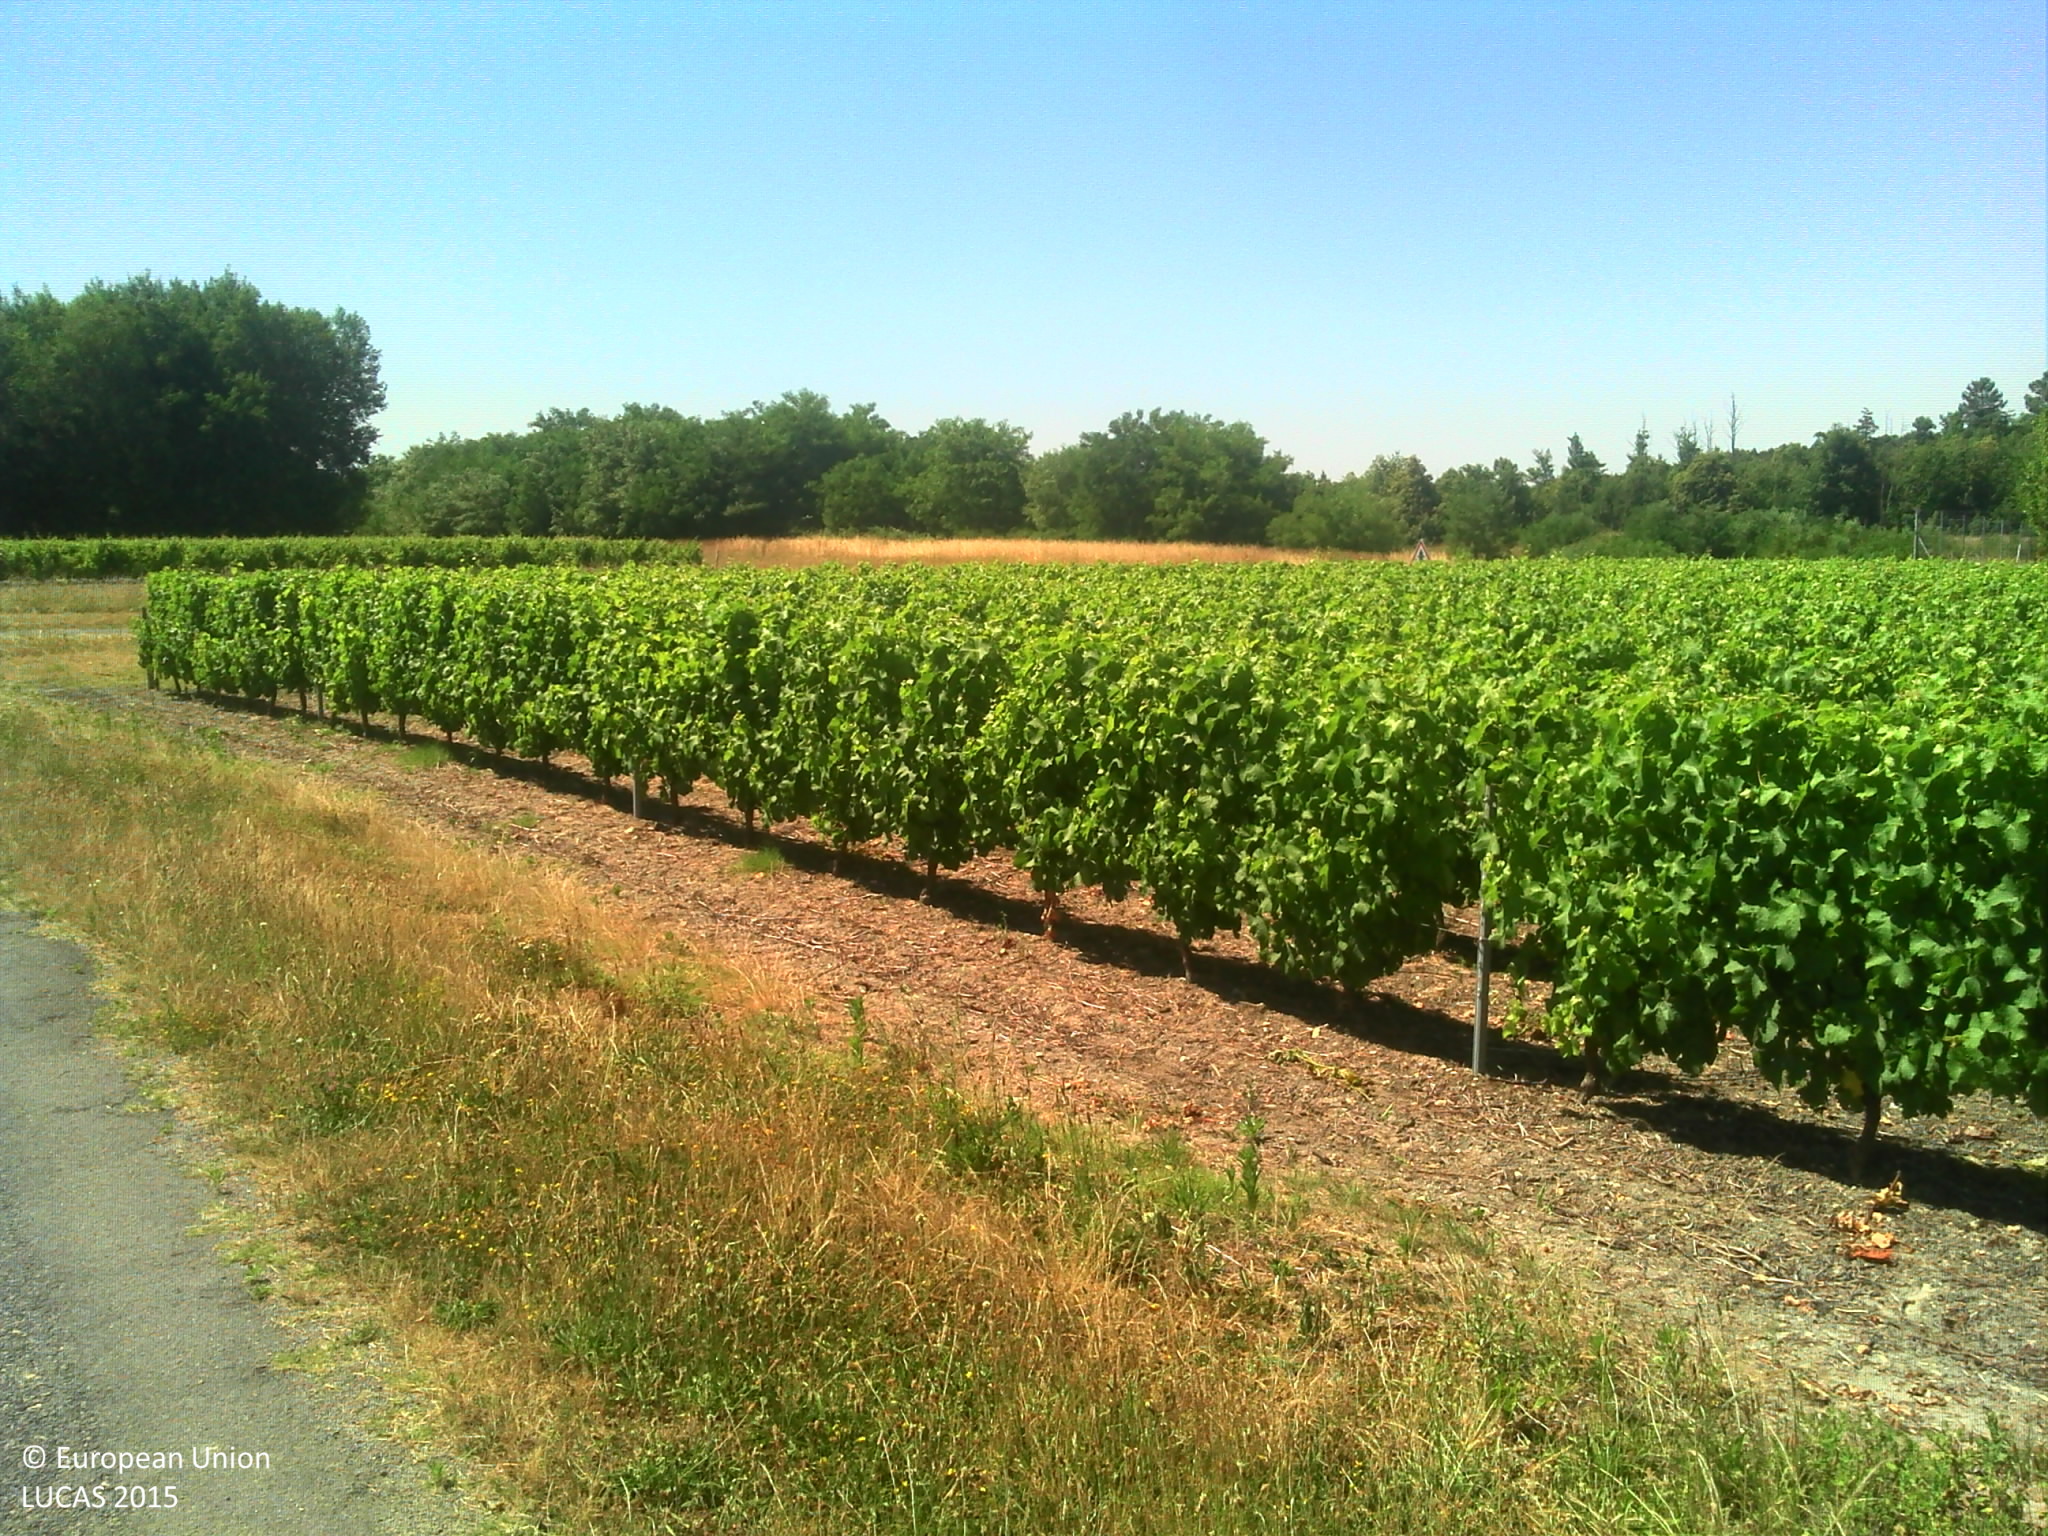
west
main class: Grassland
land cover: Grassland without tree/shrub cover
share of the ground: > 75 %
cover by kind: herbaceous plants 80 %, unconsolidated bare surface 20 %
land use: Agriculture (excluding fallow land and kitchen gardens)
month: June
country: FR
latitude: 47.3059
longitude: 1.3754
